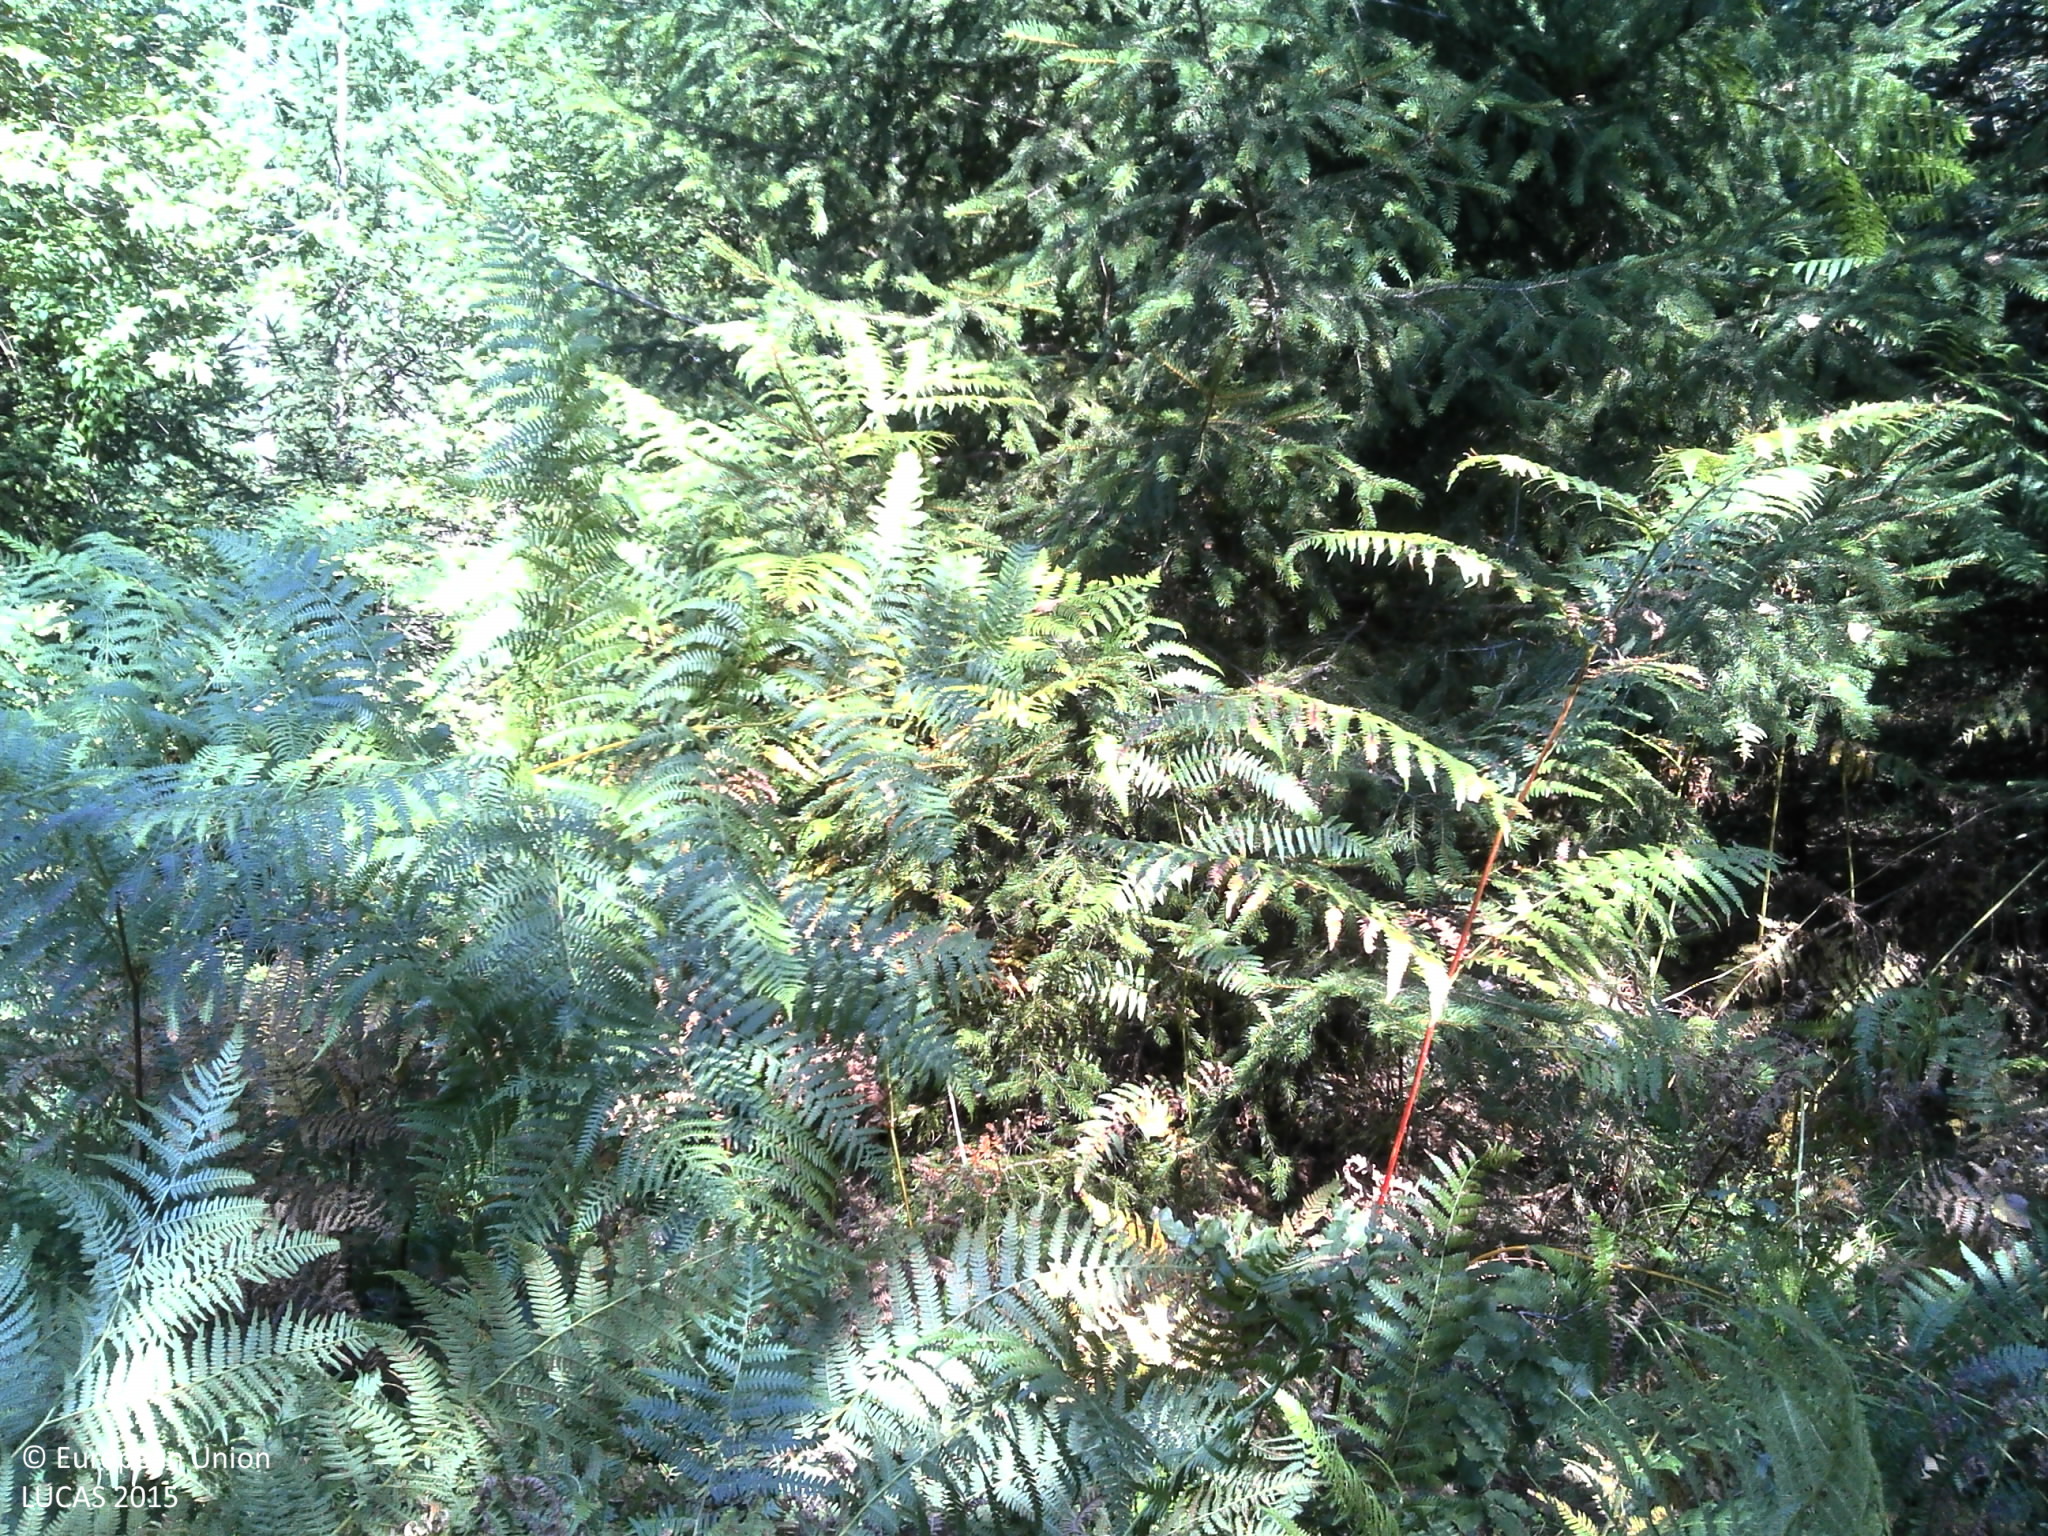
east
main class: Woodland
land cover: Spruce dominated coniferous woodland
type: coniferous forest of the mediterranean region
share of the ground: > 75 %
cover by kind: coniferous forest trees 100 %
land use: Forestry
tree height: > 5 m
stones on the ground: < 10 %
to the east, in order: Spruce dominated coniferous woodland
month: September
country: HR
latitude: 45.3177
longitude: 15.2894
